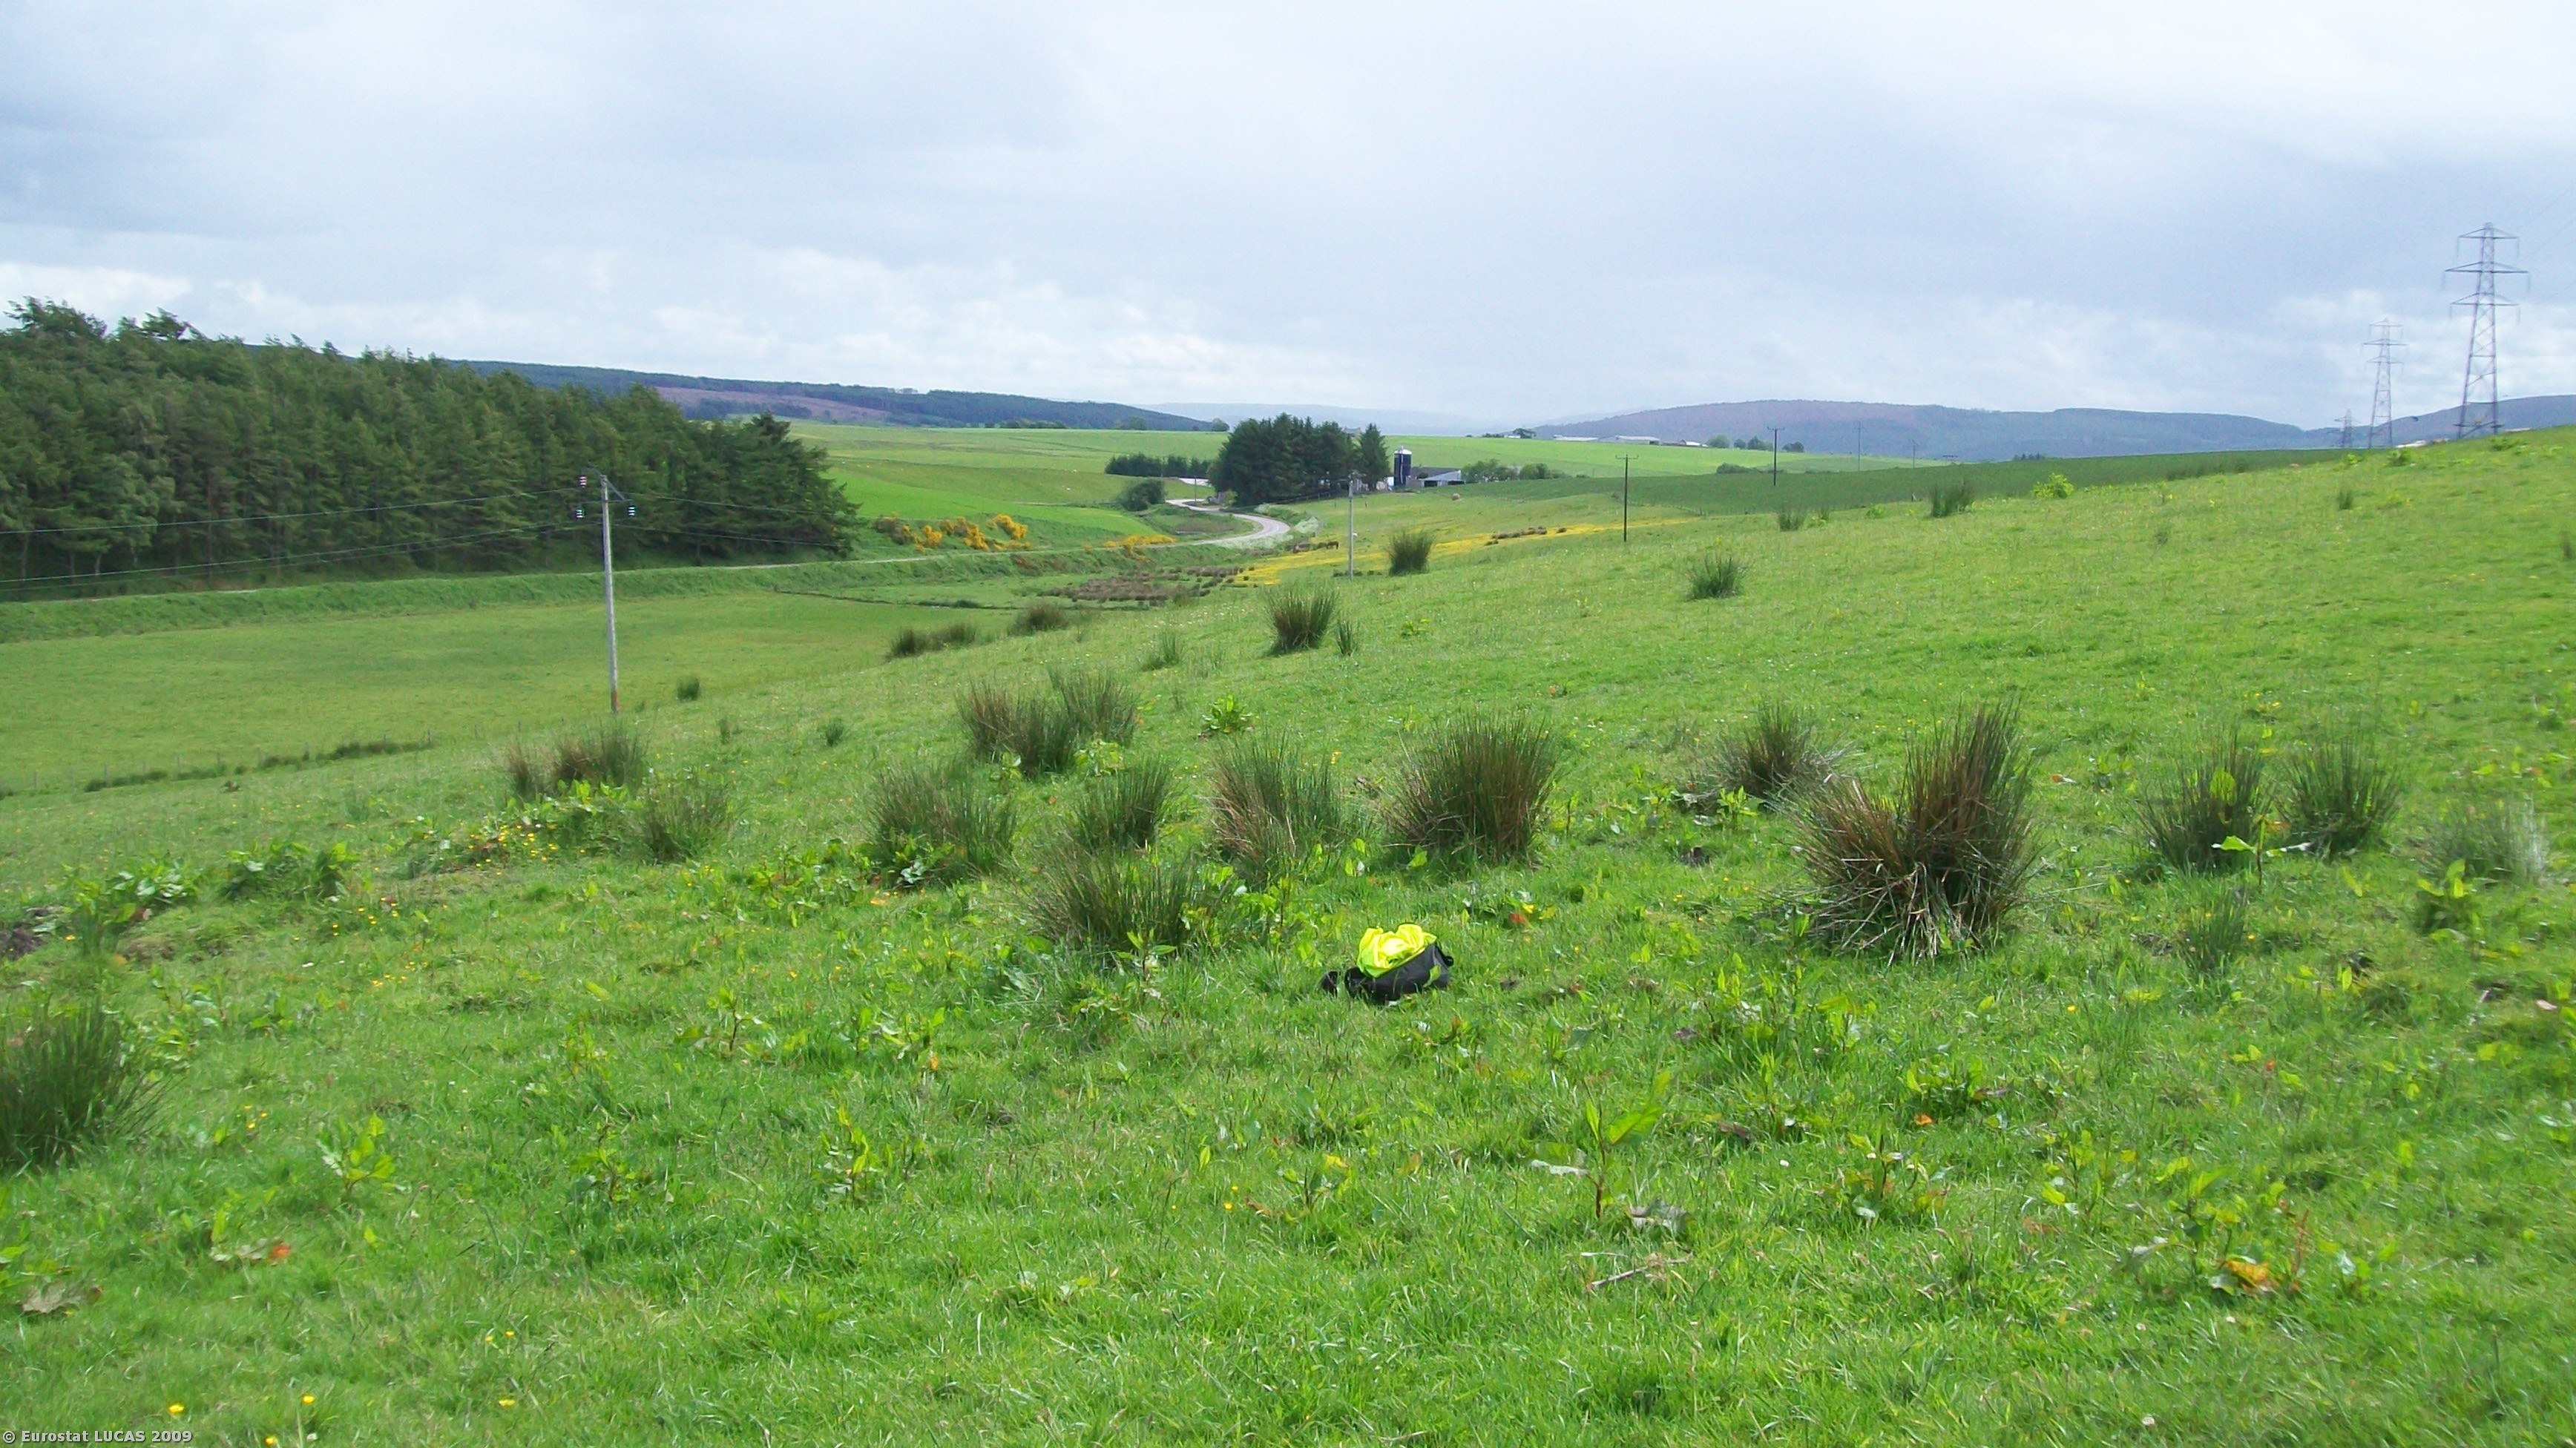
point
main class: Grassland
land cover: Grassland without tree/shrub cover
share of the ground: > 75 %
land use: Agriculture (excluding fallow land and kitchen gardens)
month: June
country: GB
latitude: 57.5985
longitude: -2.8584
